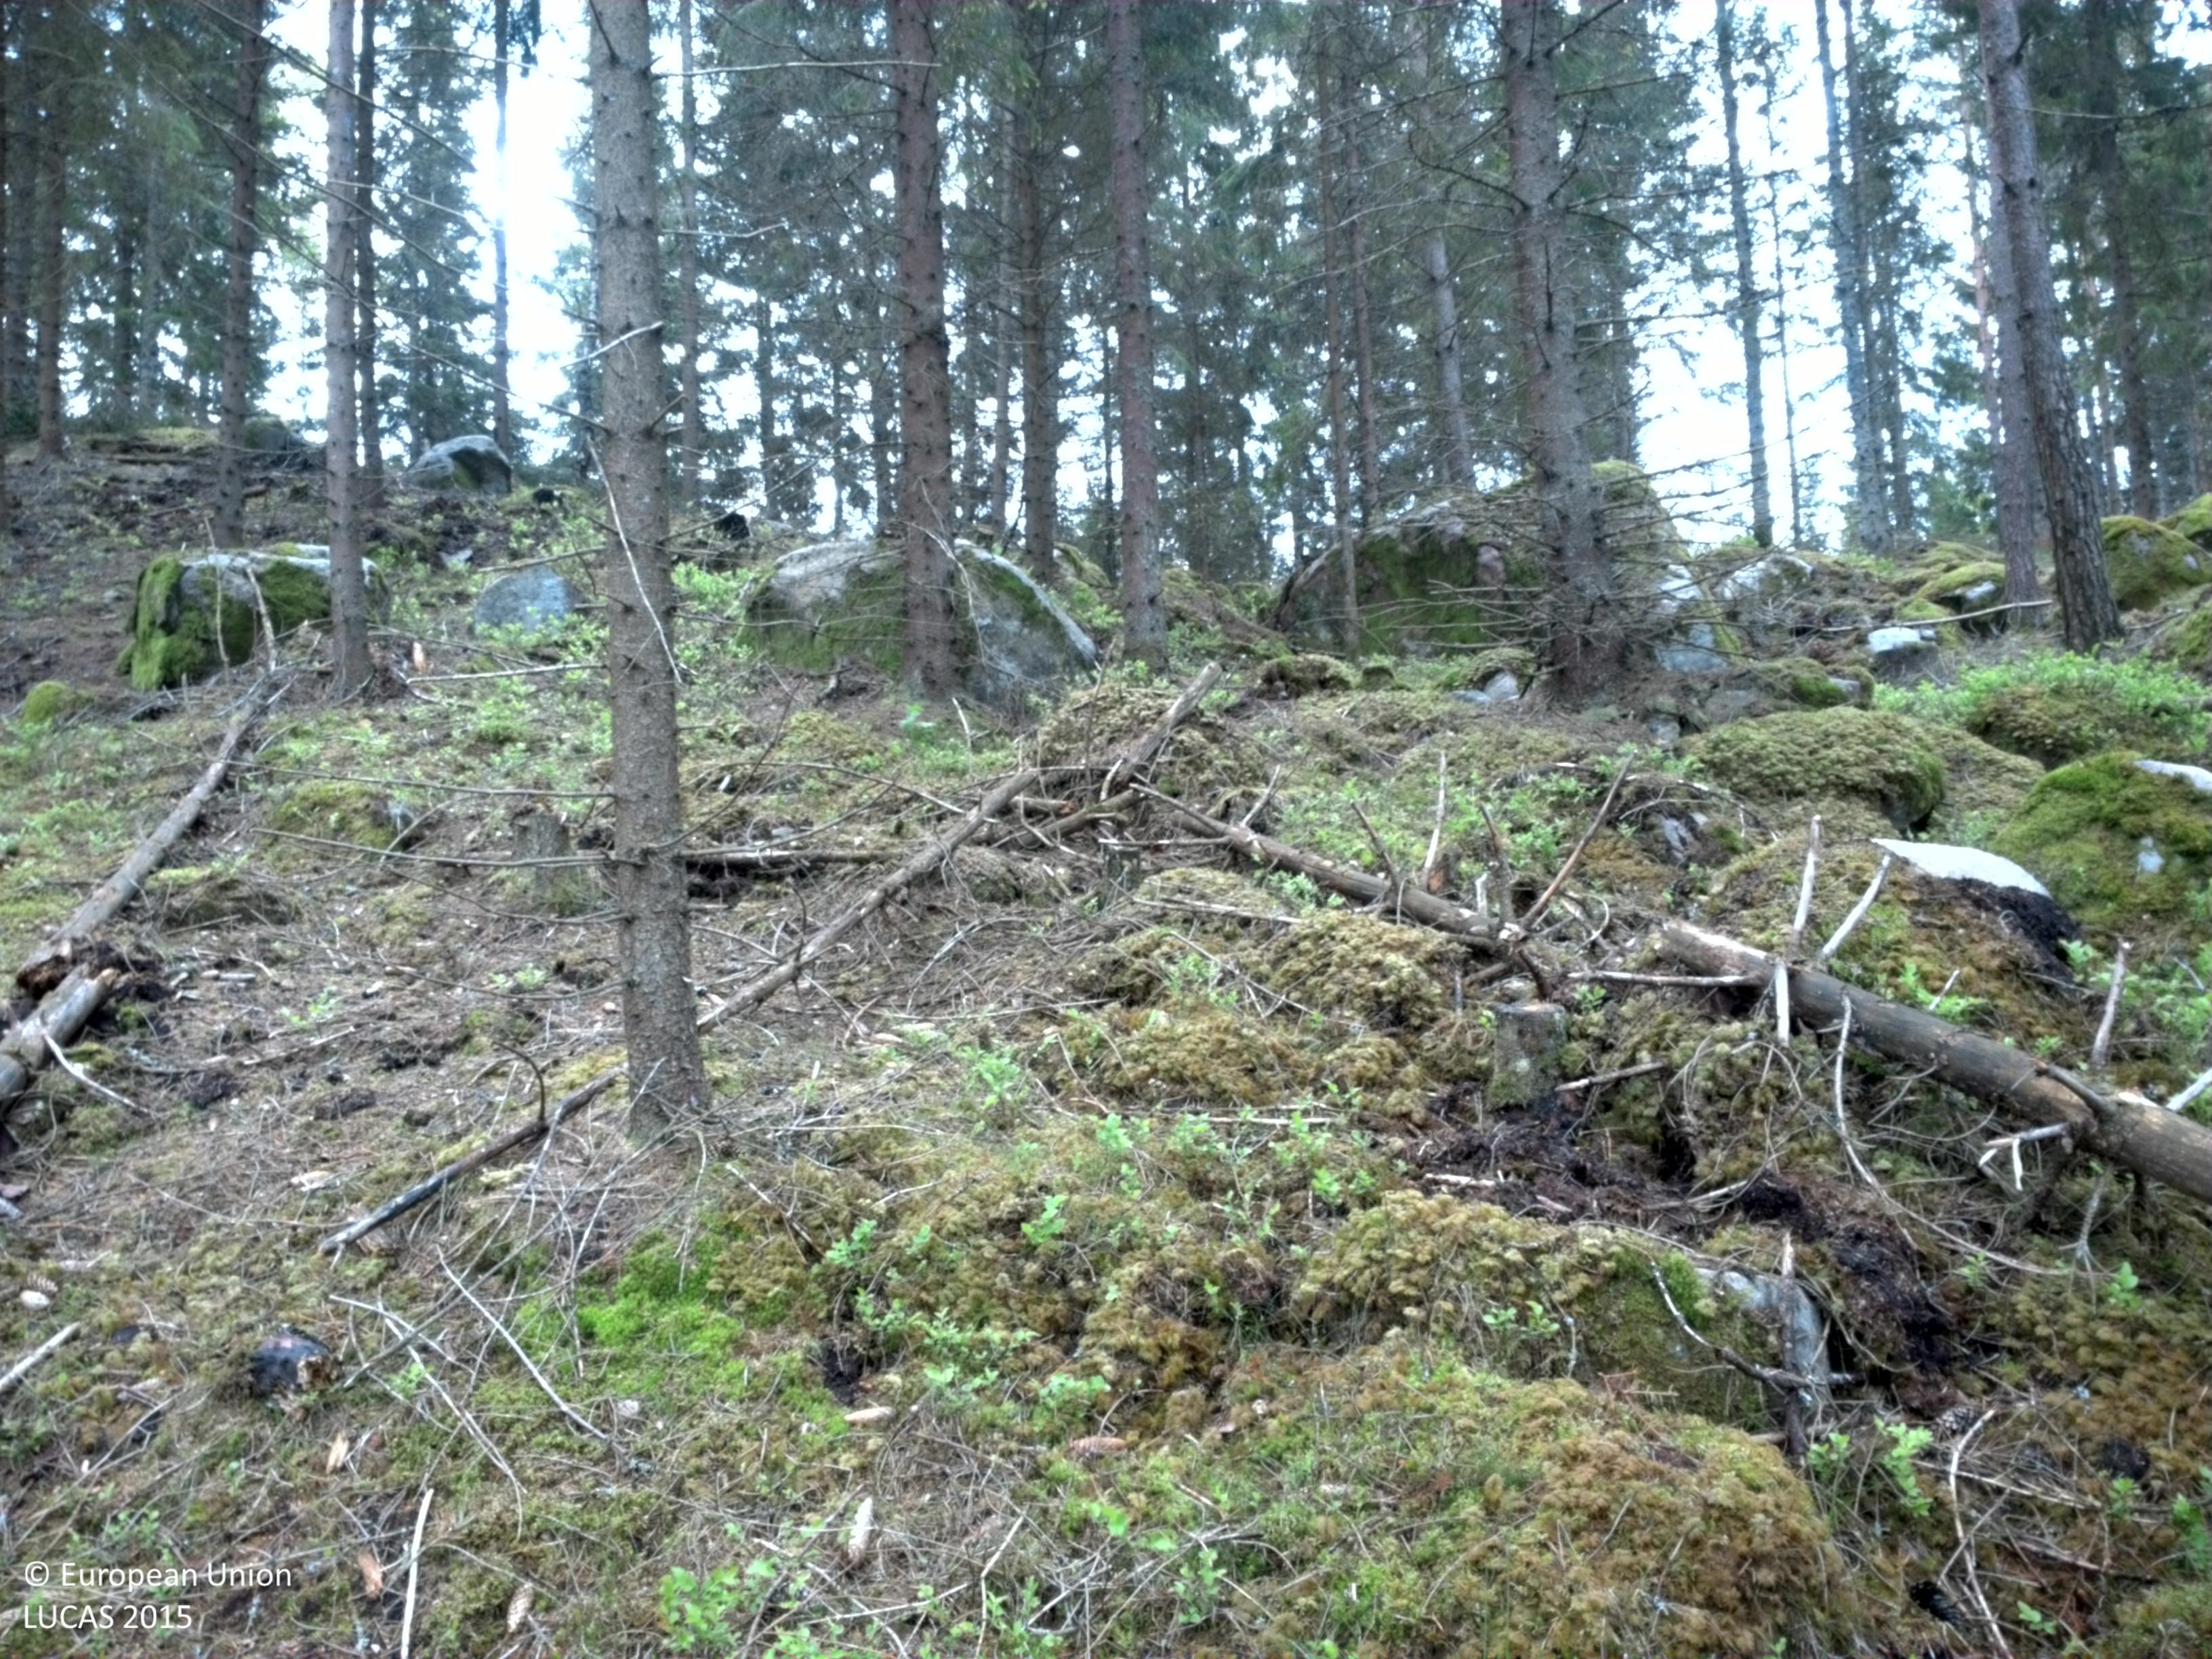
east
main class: Woodland
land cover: Spruce dominated coniferous woodland
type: boreal forest
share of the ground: 50 - 75 %
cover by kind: coniferous forest trees 50 %, shrubs 25 %, lichens and mosses 15 %, broadleaved forest trees 5 %, herbaceous plants 5 %
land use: Forestry
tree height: > 5 m
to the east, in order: Spruce dominated coniferous woodland; Tracks; Spruce dominated coniferous woodland; Pine dominated coniferous woodland; Ditches and canals; Pine dominated coniferous woodland; Spruce dominated coniferous woodland; Tracks; Spruce dominated coniferous woodland
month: June
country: SE
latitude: 56.7640
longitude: 14.2994
